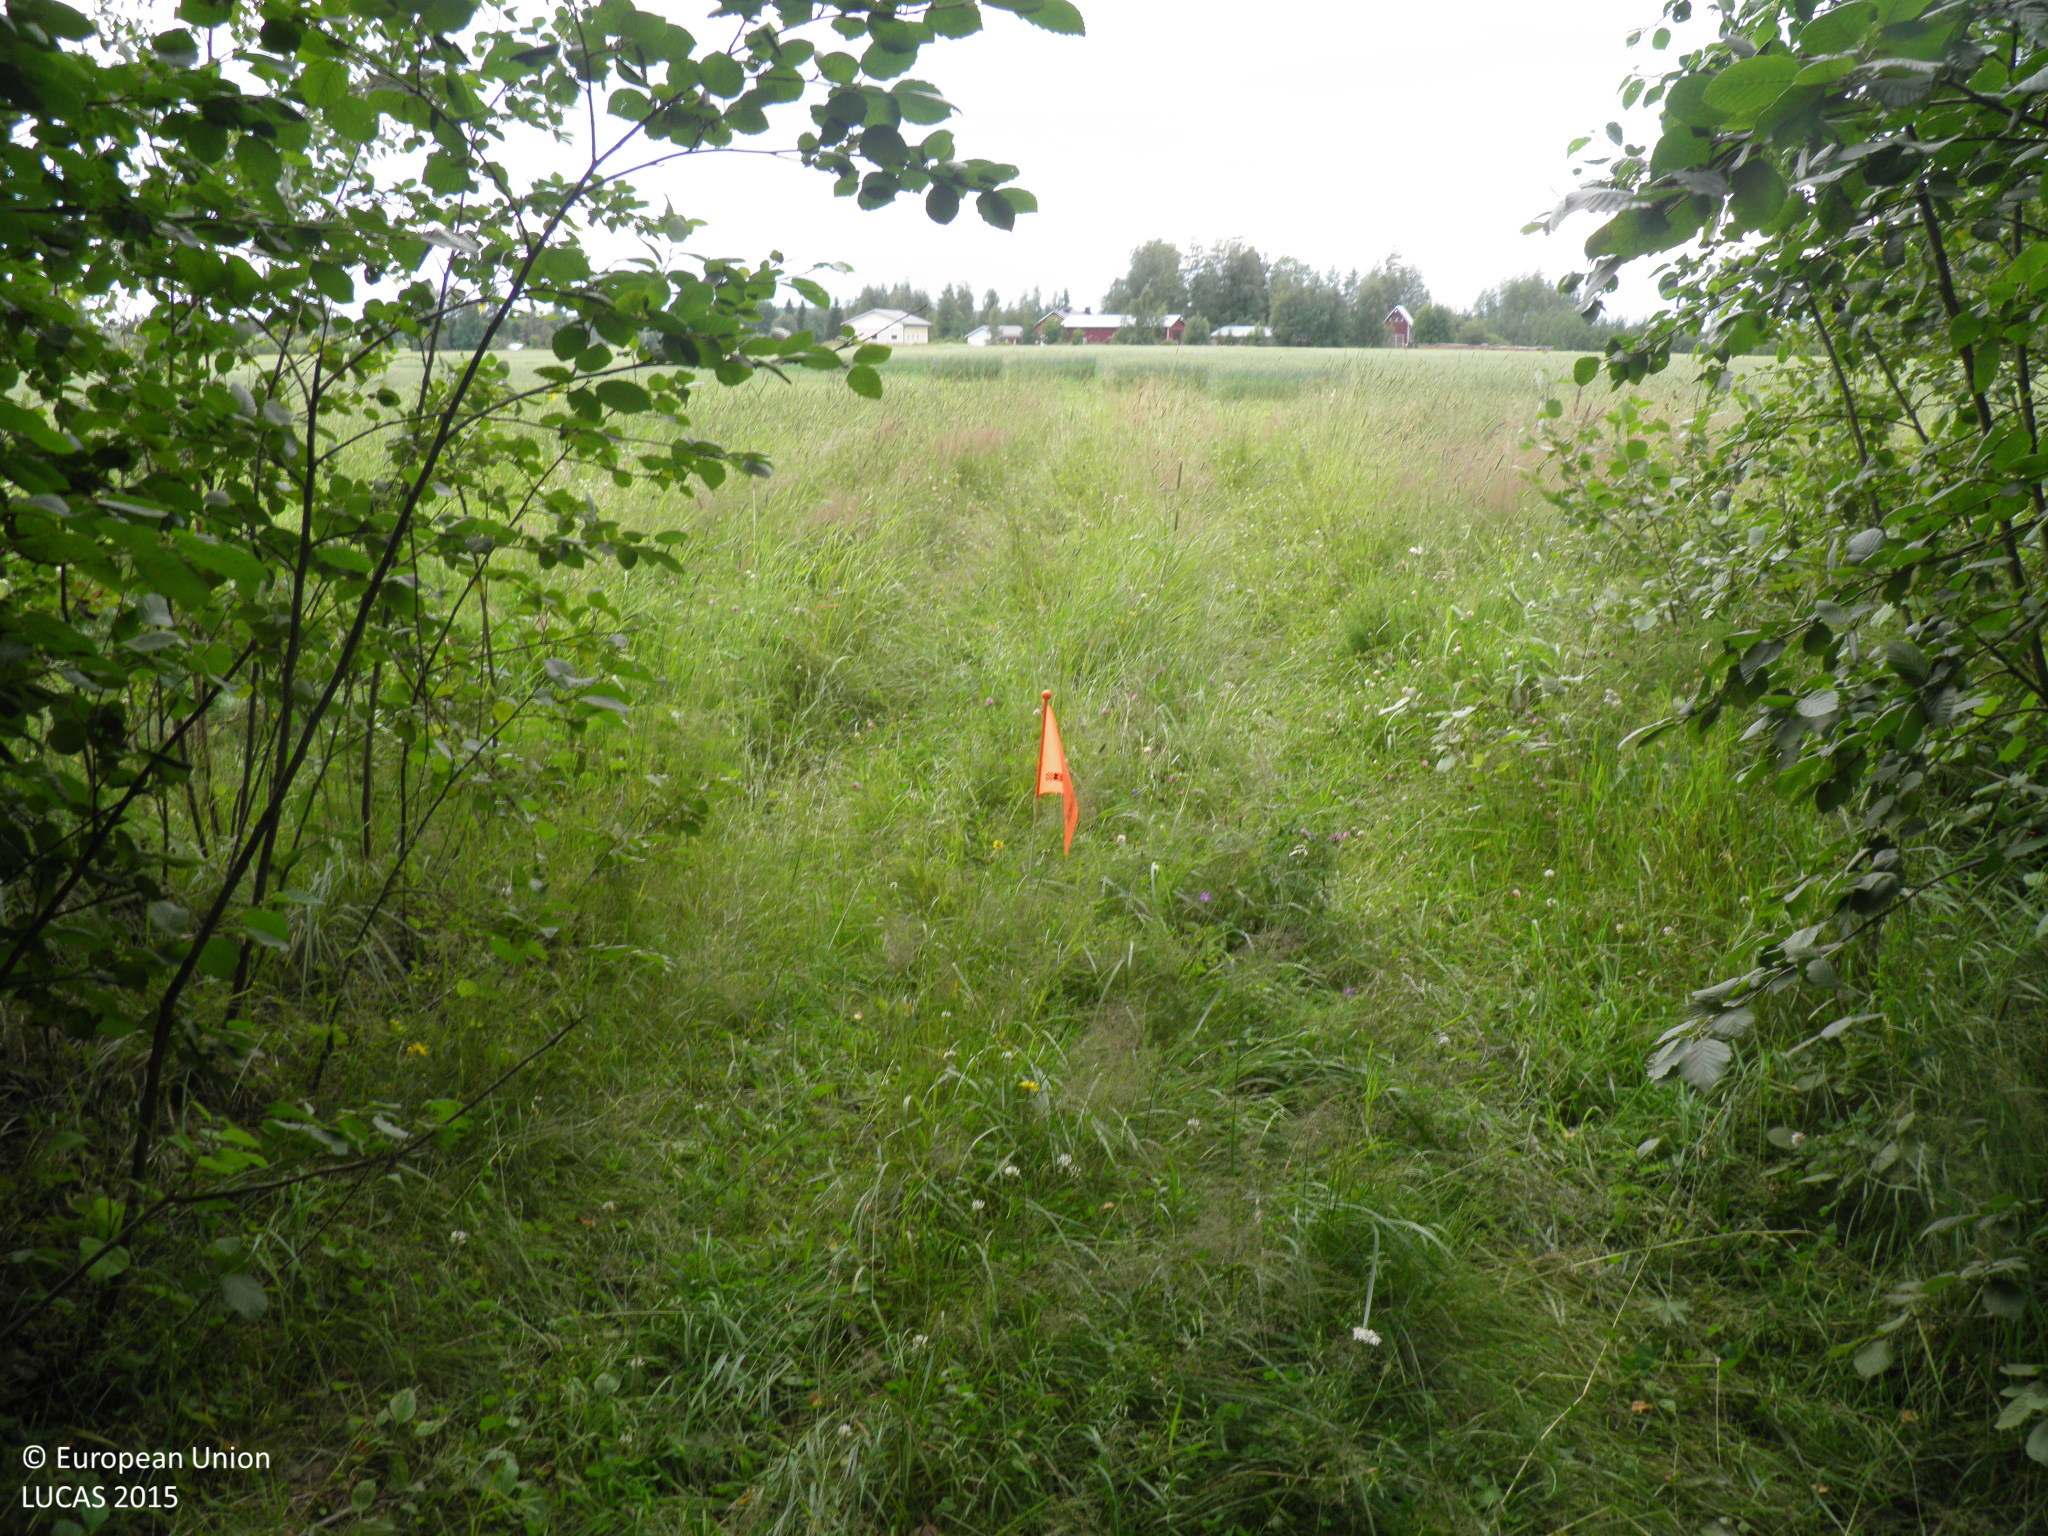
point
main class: Woodland
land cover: Spruce dominated coniferous woodland
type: boreal forest
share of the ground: 50 - 75 %
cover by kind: coniferous forest trees 60 %, broadleaved forest trees 10 %, shrubs 10 %, herbaceous plants 10 %, lichens and mosses 10 %
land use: Forestry
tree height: > 5 m
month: August
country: FI
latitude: 61.0748
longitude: 22.8041
